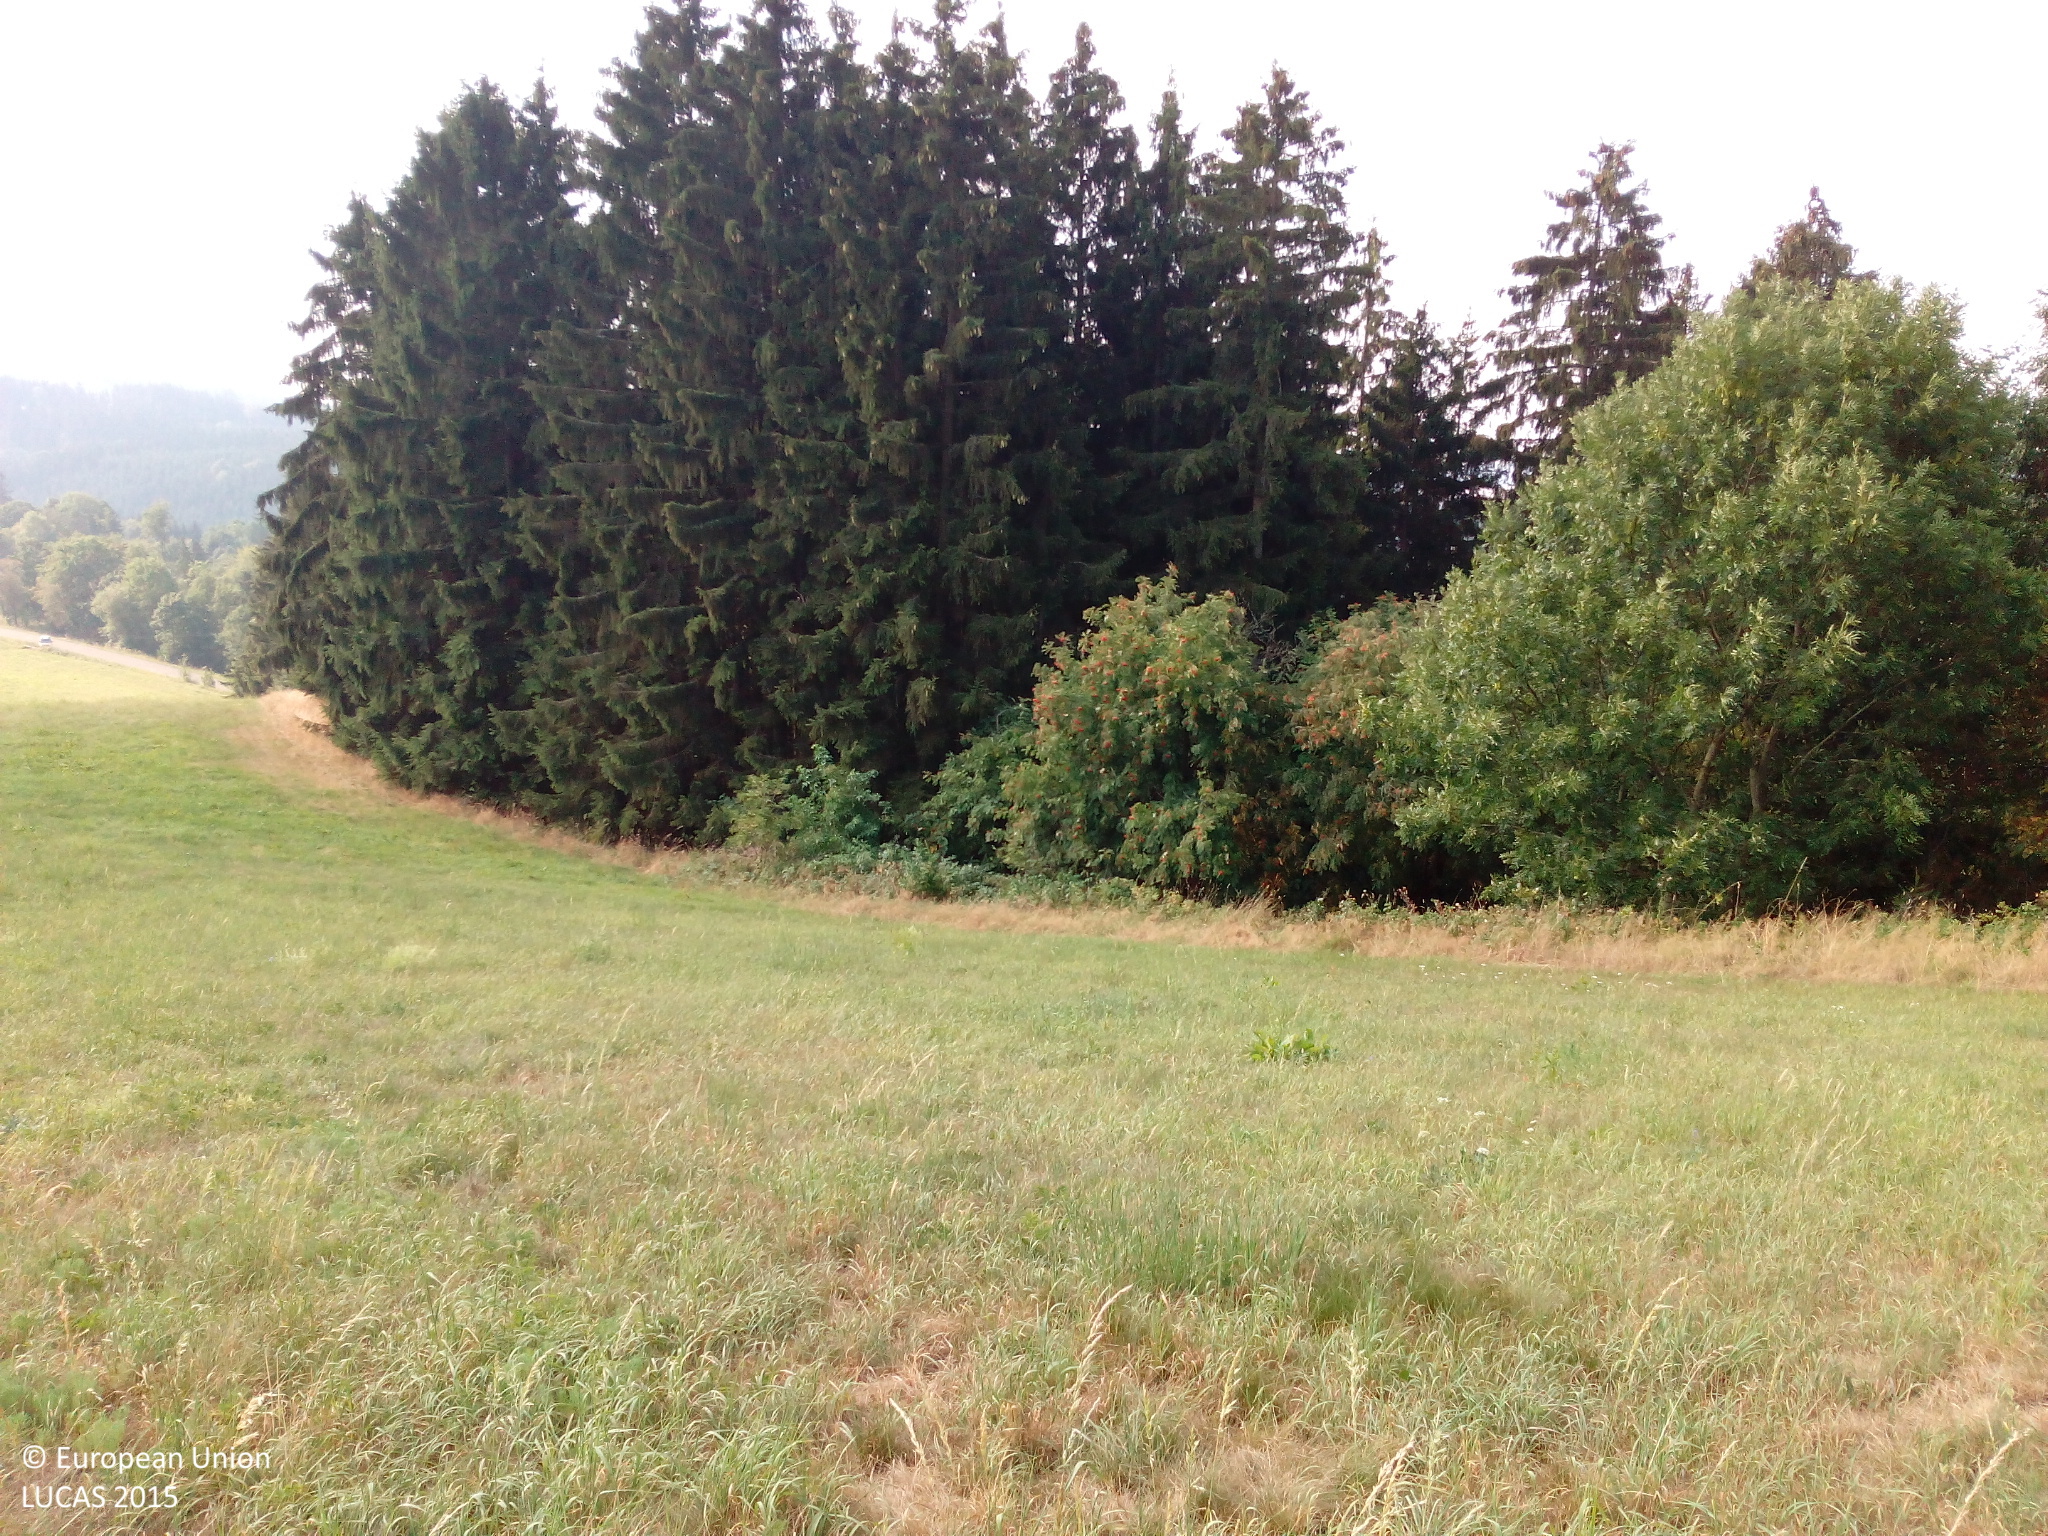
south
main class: Grassland
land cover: Grassland without tree/shrub cover
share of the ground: 25 - 50 %
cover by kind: herbaceous plants 45 %, unconsolidated bare surface 20 %
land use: Agriculture (excluding fallow land and kitchen gardens)
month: August
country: DE
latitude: 50.2272
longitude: 11.5836
